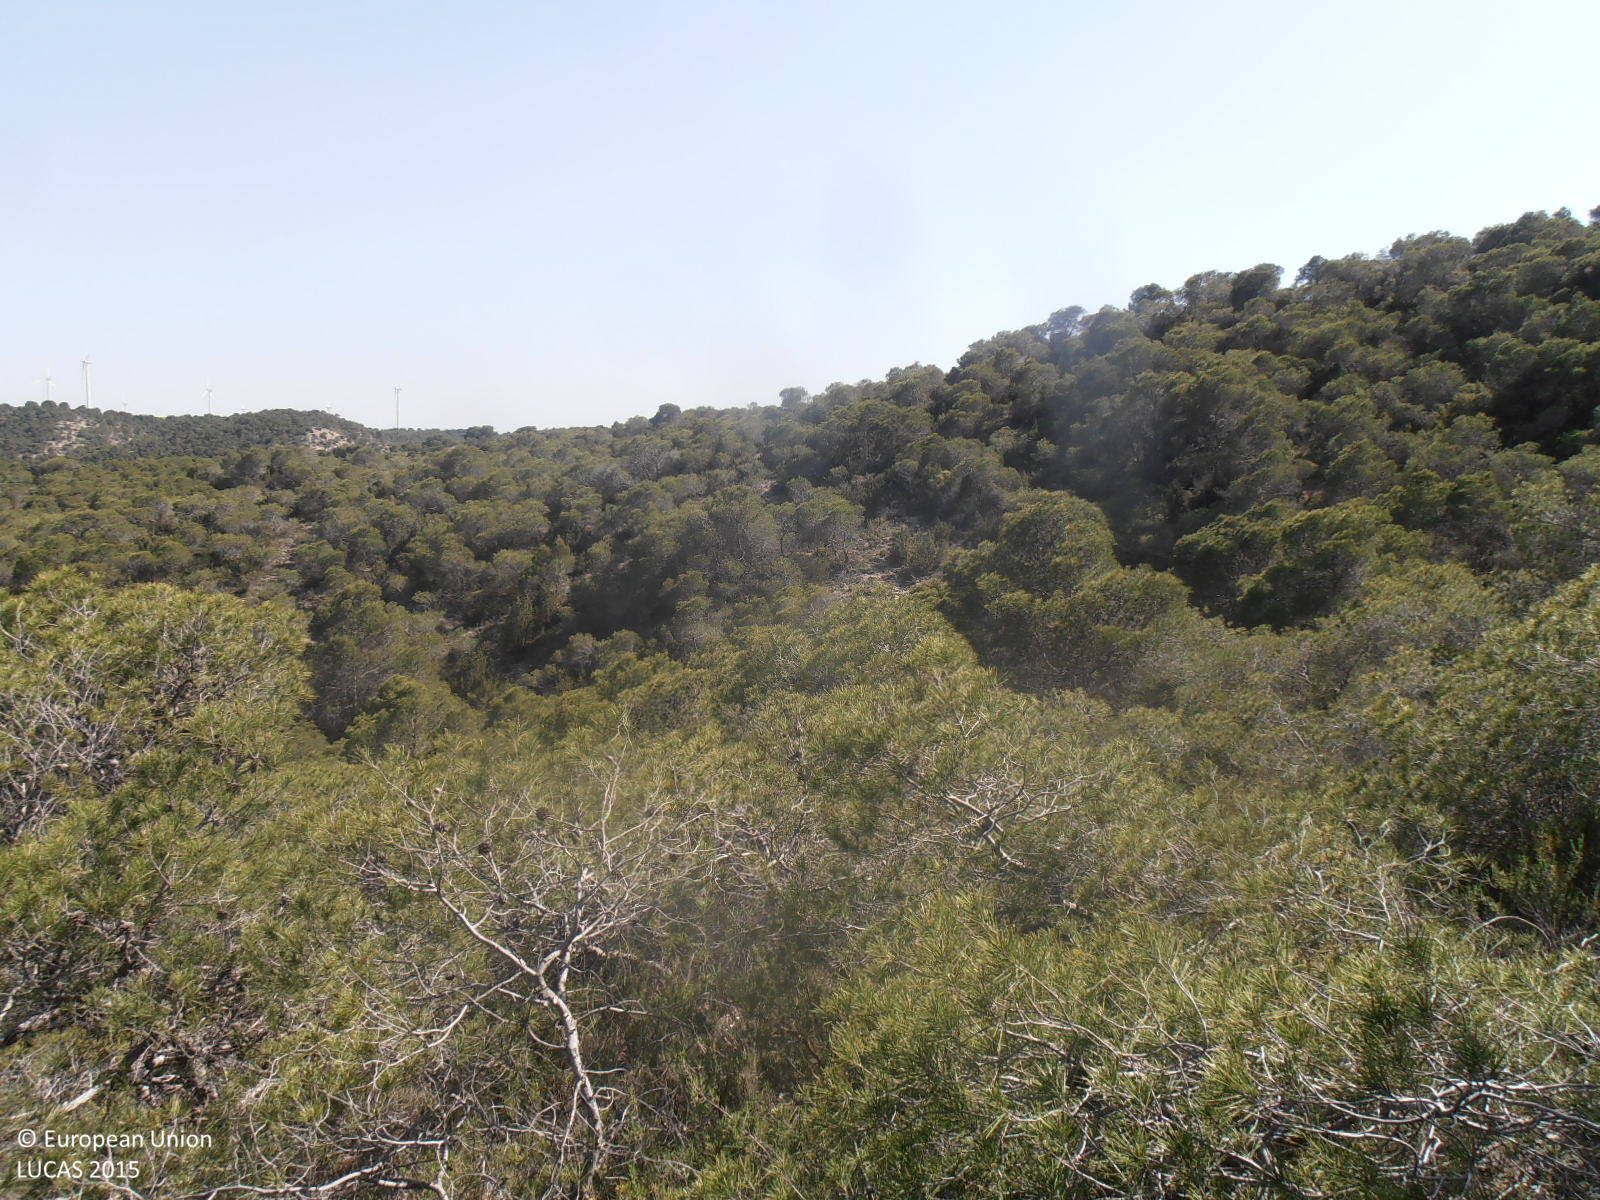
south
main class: Woodland
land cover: Pine dominated coniferous woodland
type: coniferous forest of the mediterranean region
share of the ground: 50 - 75 %
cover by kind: coniferous forest trees 80 %, shrubs 10 %, consolidated bare surface 10 %
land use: Forestry
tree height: > 5 m
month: May
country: ES
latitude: 41.4931
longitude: -0.9570
